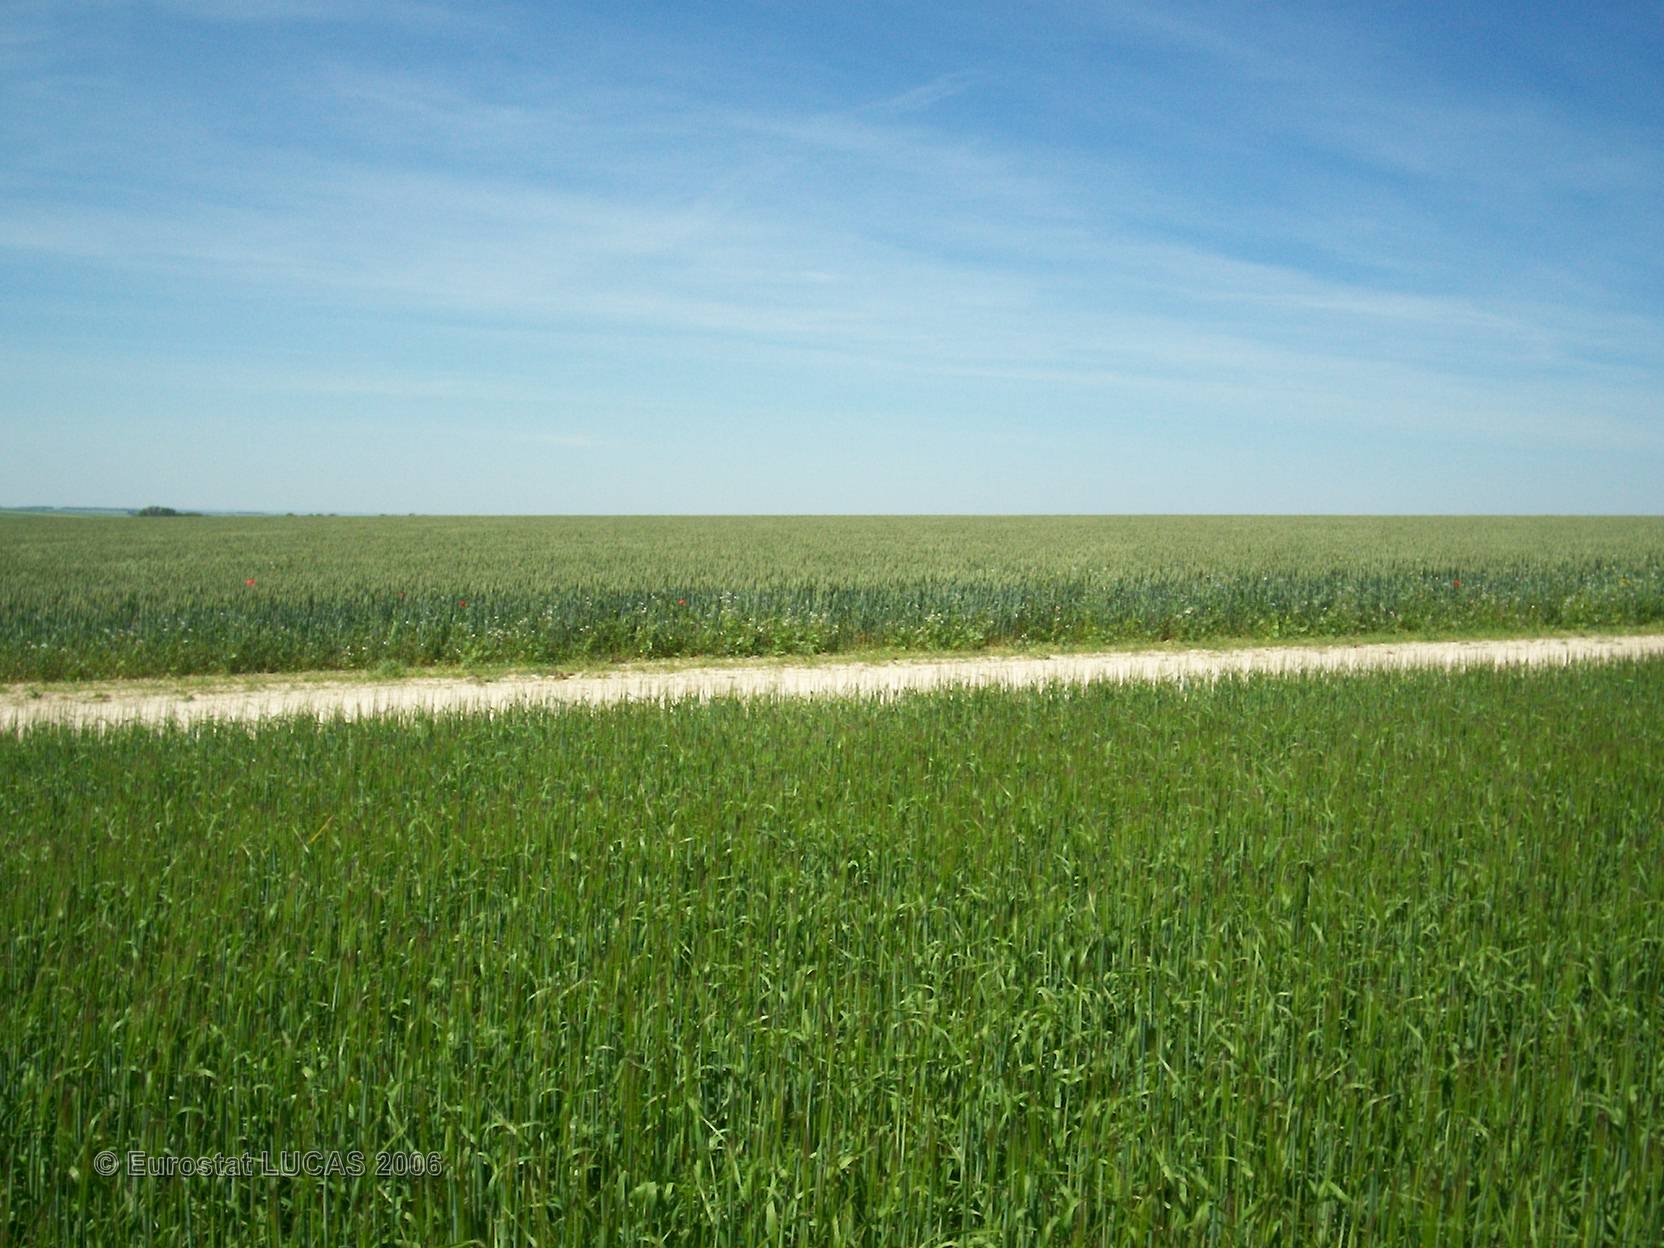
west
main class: Cropland
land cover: Barley
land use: Agriculture (excluding fallow land and kitchen gardens)
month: June
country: FR
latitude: 49.0645
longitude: 4.5906
